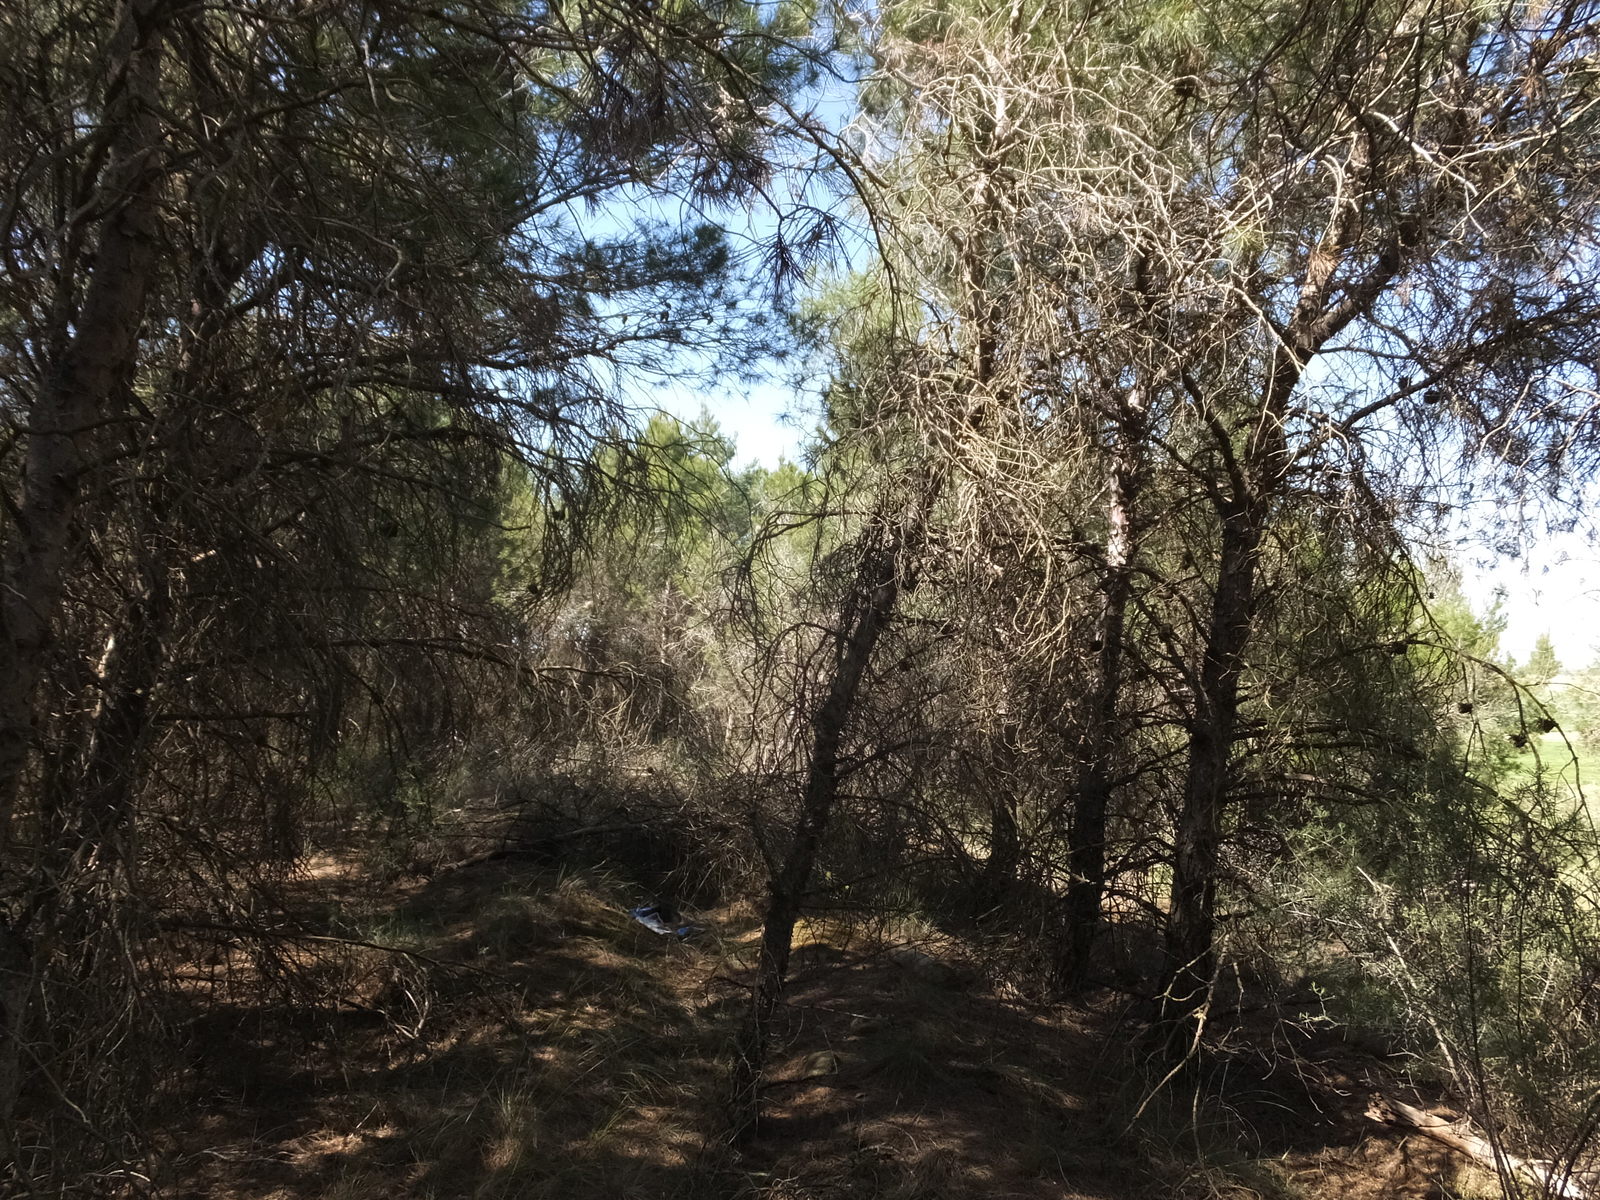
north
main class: Woodland
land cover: Pine dominated mixed woodland
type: coniferous forest of the mediterranean region
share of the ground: > 75 %
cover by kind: coniferous forest trees 50 %, broadleaved forest trees 25 %, herbaceous plants 25 %
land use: Forestry
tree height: > 5 m
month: May
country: ES
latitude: 41.6845
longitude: 0.3630
